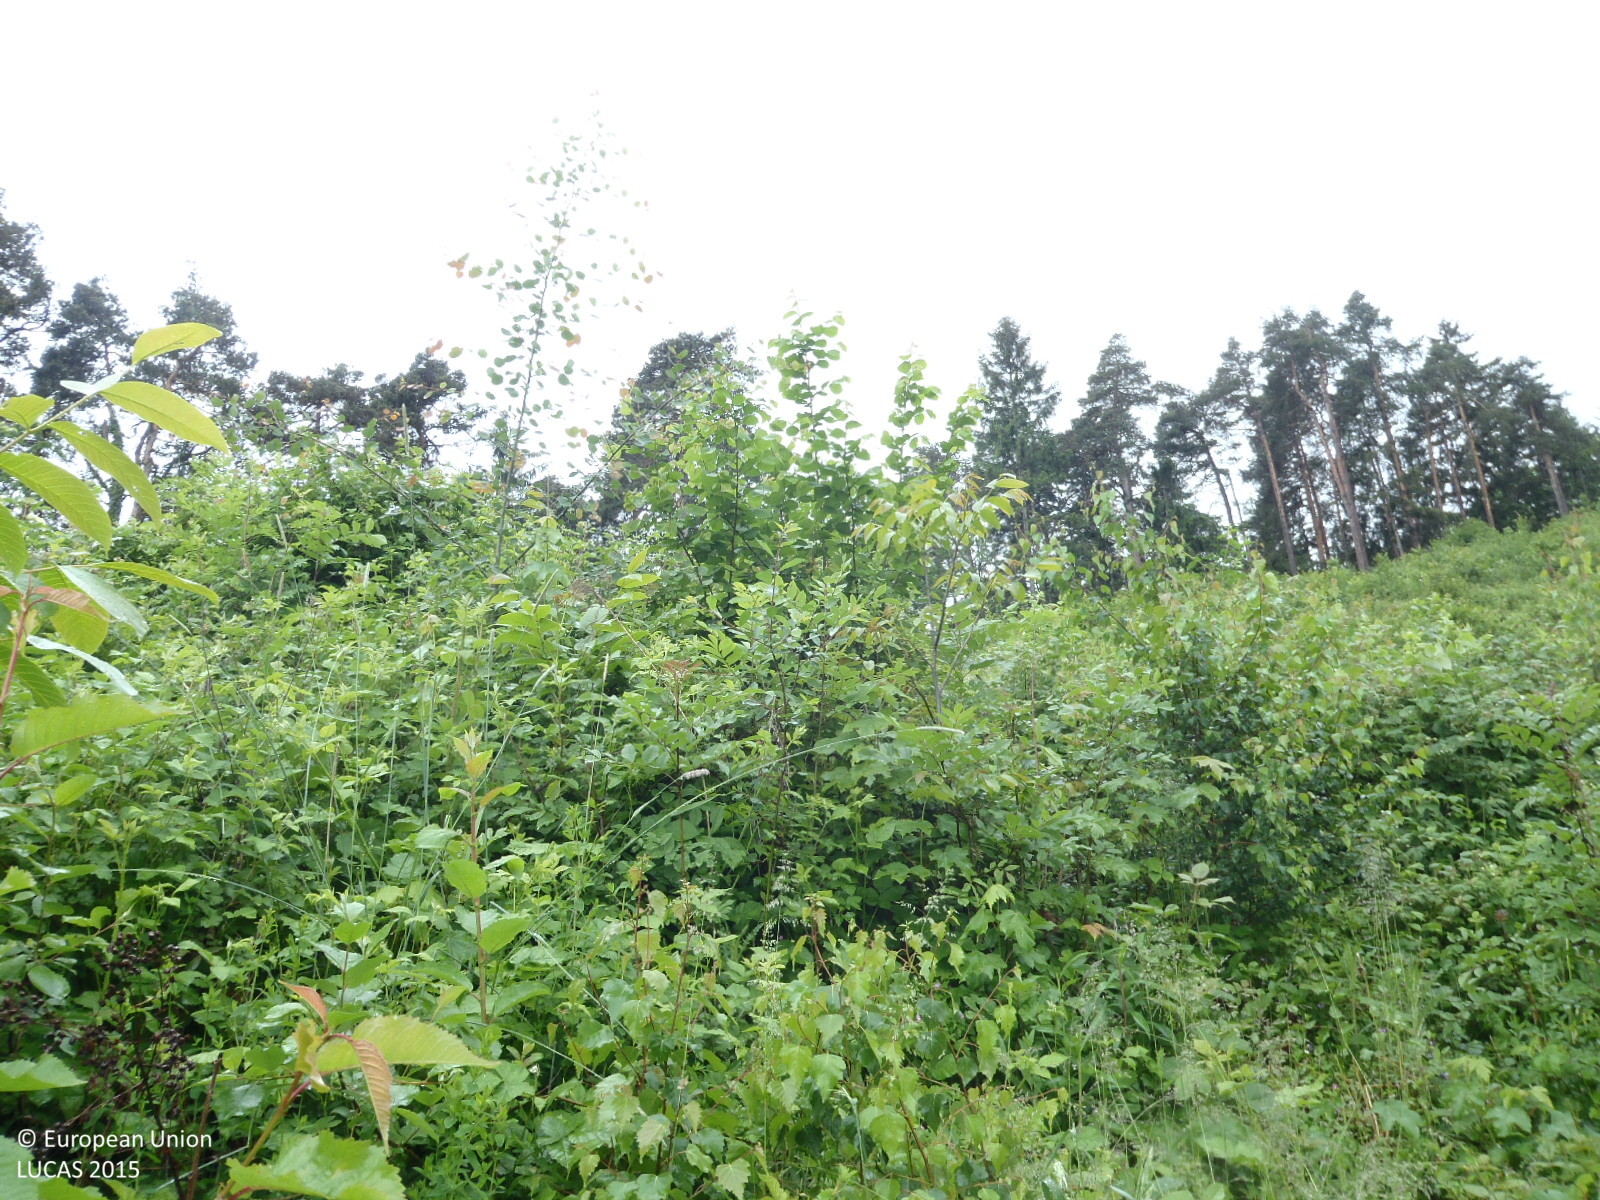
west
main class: Shrubland
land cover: Shrubland with sparse tree cover
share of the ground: > 75 %
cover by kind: shrubs 85 %, herbaceous plants 10 %, broadleaved forest trees 5 %
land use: Forestry
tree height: < 5 m
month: May
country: AT
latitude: 47.2957
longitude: 11.4666
